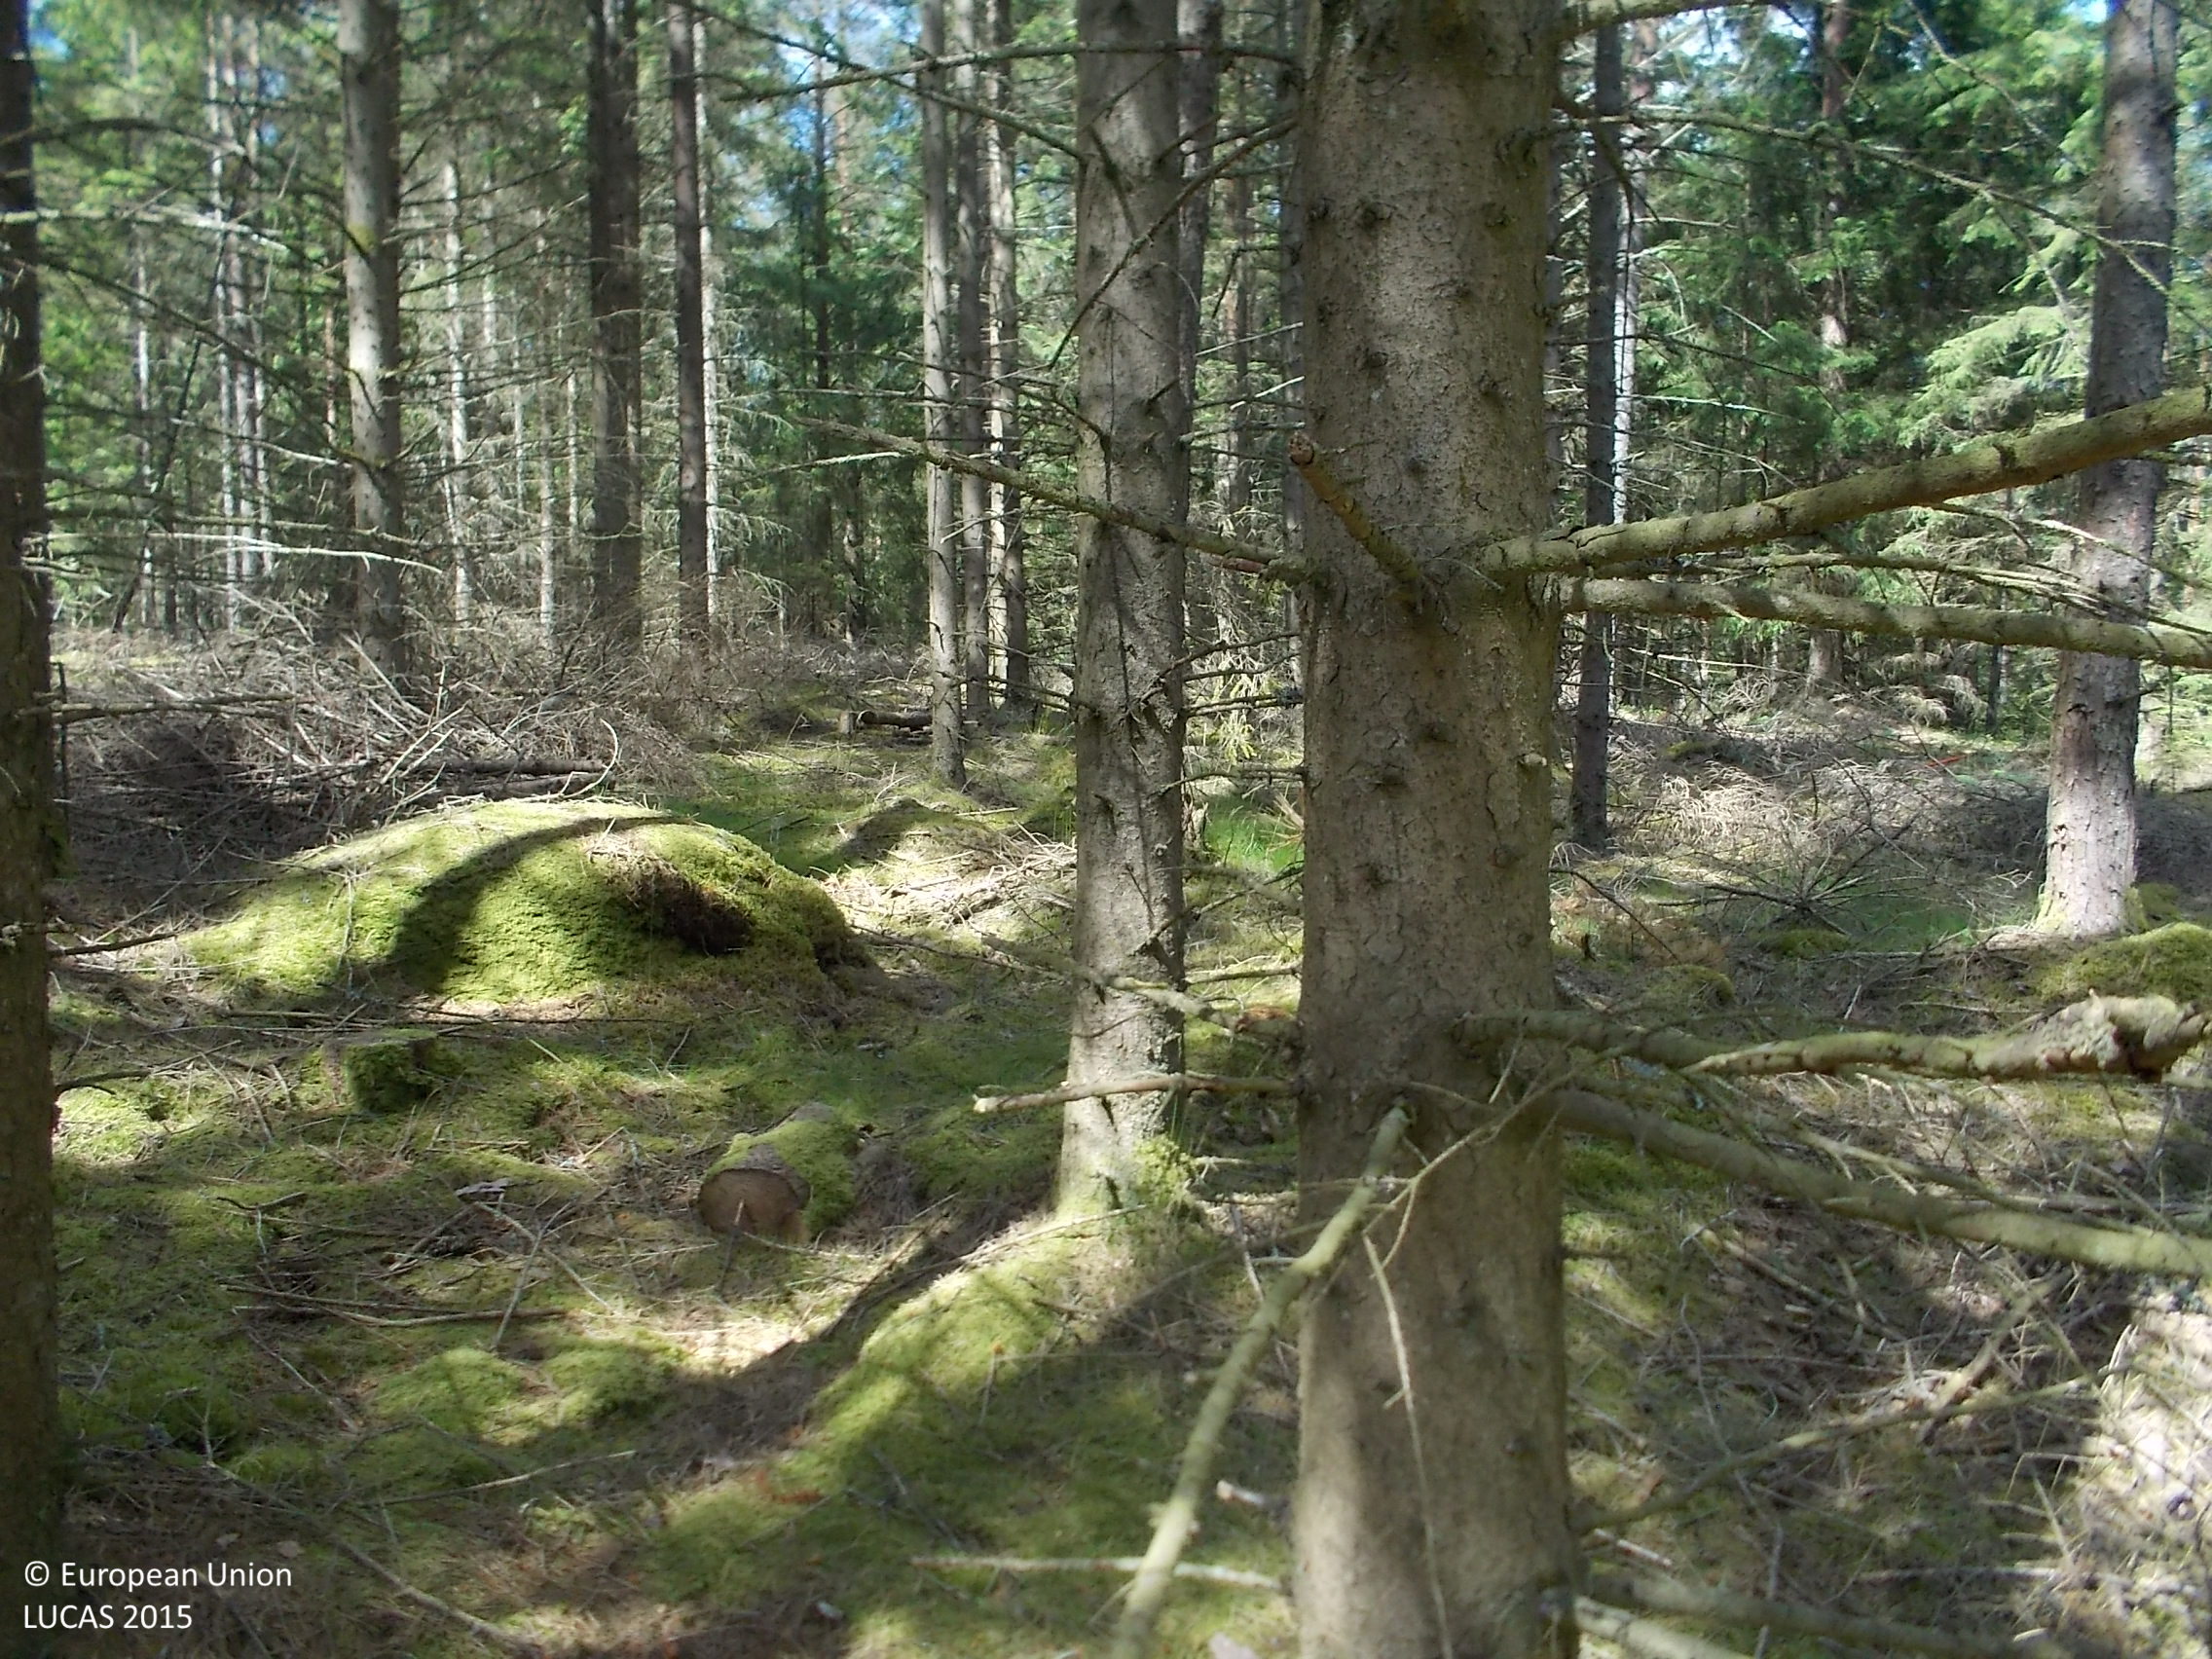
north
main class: Woodland
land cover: Spruce dominated coniferous woodland
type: boreal forest
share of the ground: > 75 %
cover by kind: coniferous forest trees 90 %, herbaceous plants 5 %, lichens and mosses 5 %
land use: Forestry
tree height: > 5 m
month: June
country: SE
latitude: 57.3206
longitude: 13.0681
